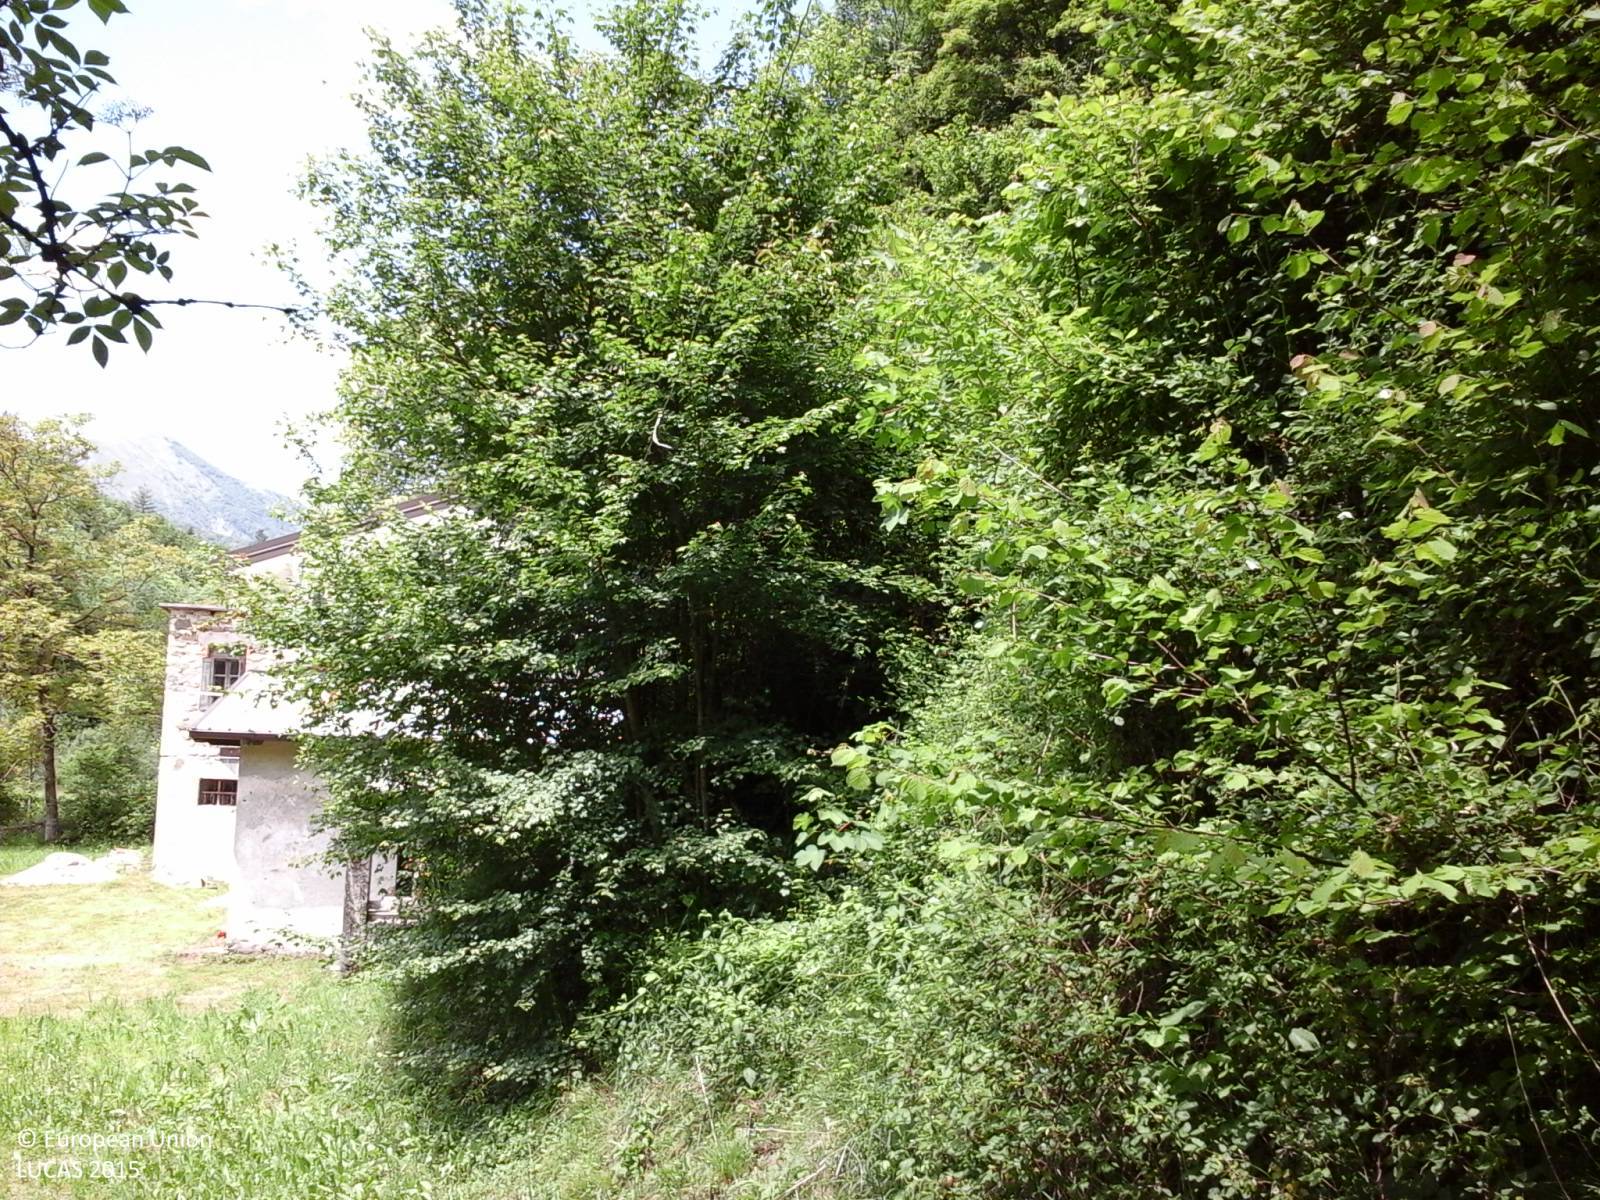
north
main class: Woodland
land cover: Broadleaved woodland
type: thermophilous deciduous forest
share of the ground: > 75 %
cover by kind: broadleaved forest trees 75 %, coniferous forest trees 25 %
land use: Forestry
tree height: > 5 m
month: May
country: IT
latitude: 46.2657
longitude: 13.2533
